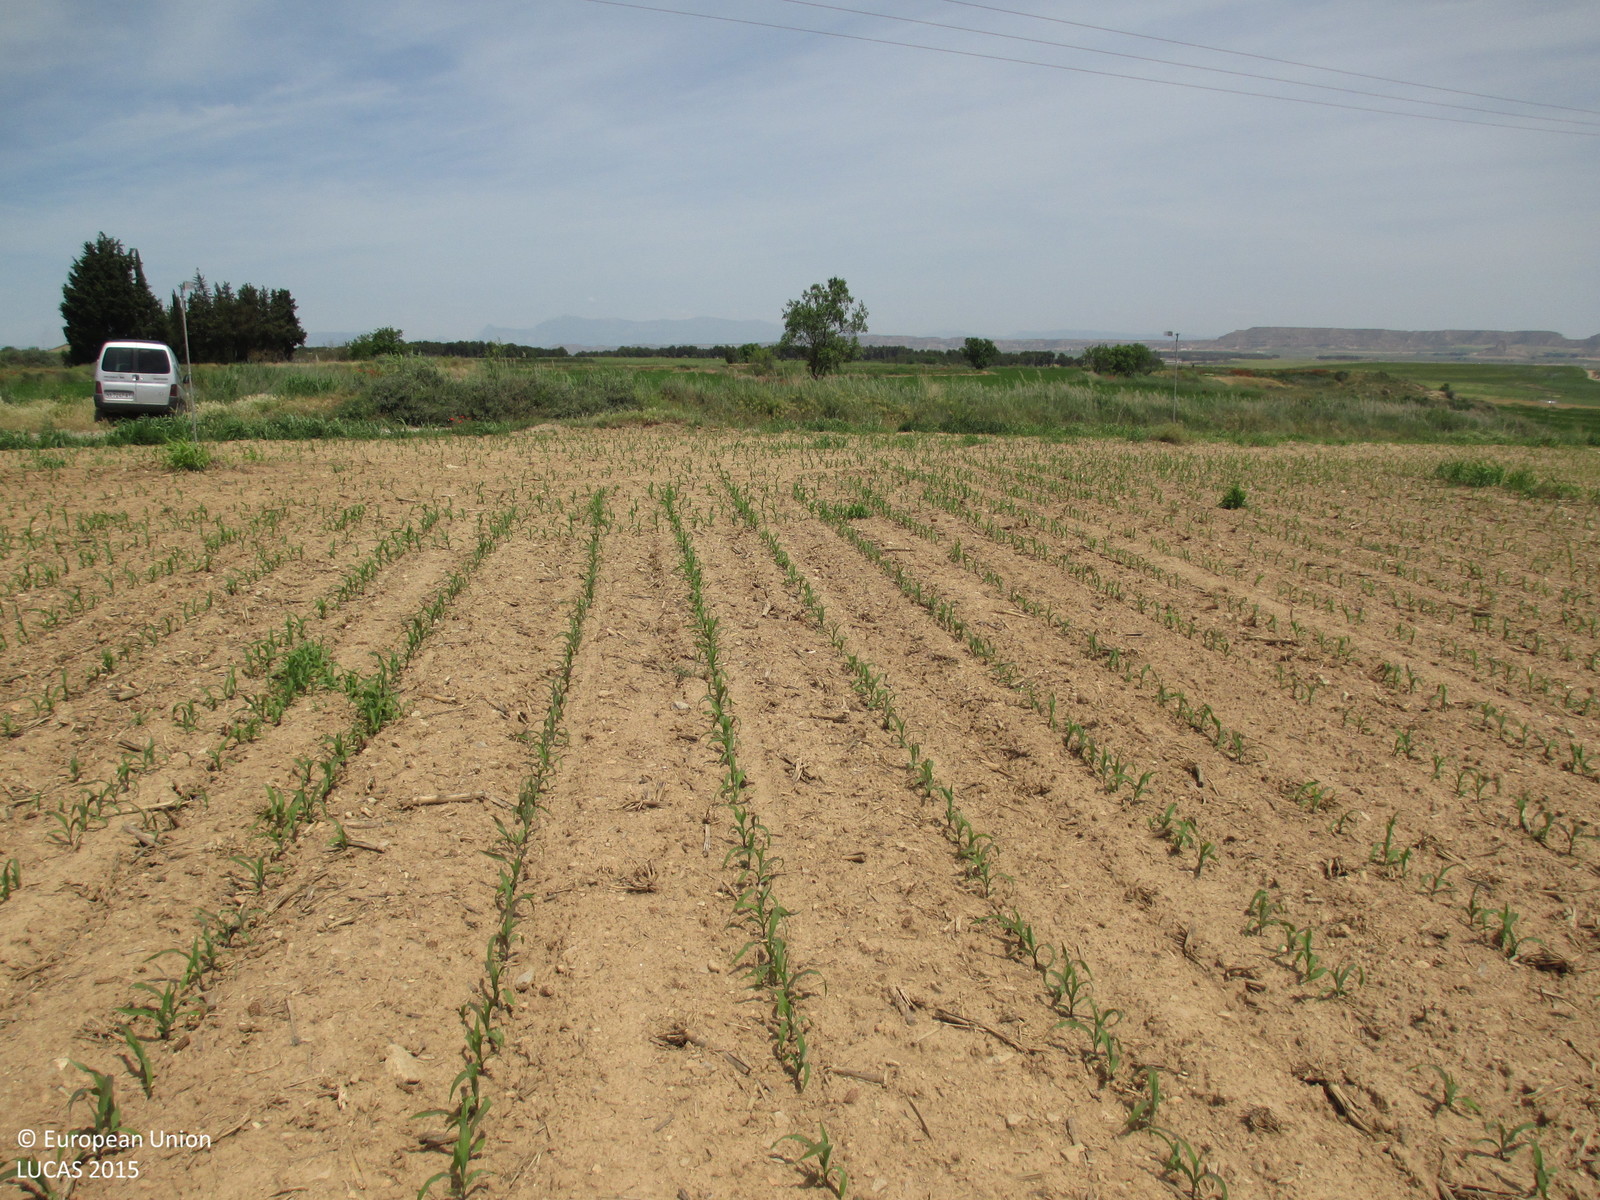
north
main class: Cropland
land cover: Maize
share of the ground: < 10 %
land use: Agriculture (excluding fallow land and kitchen gardens)
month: May
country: ES
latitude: 41.8682
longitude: -0.3449
